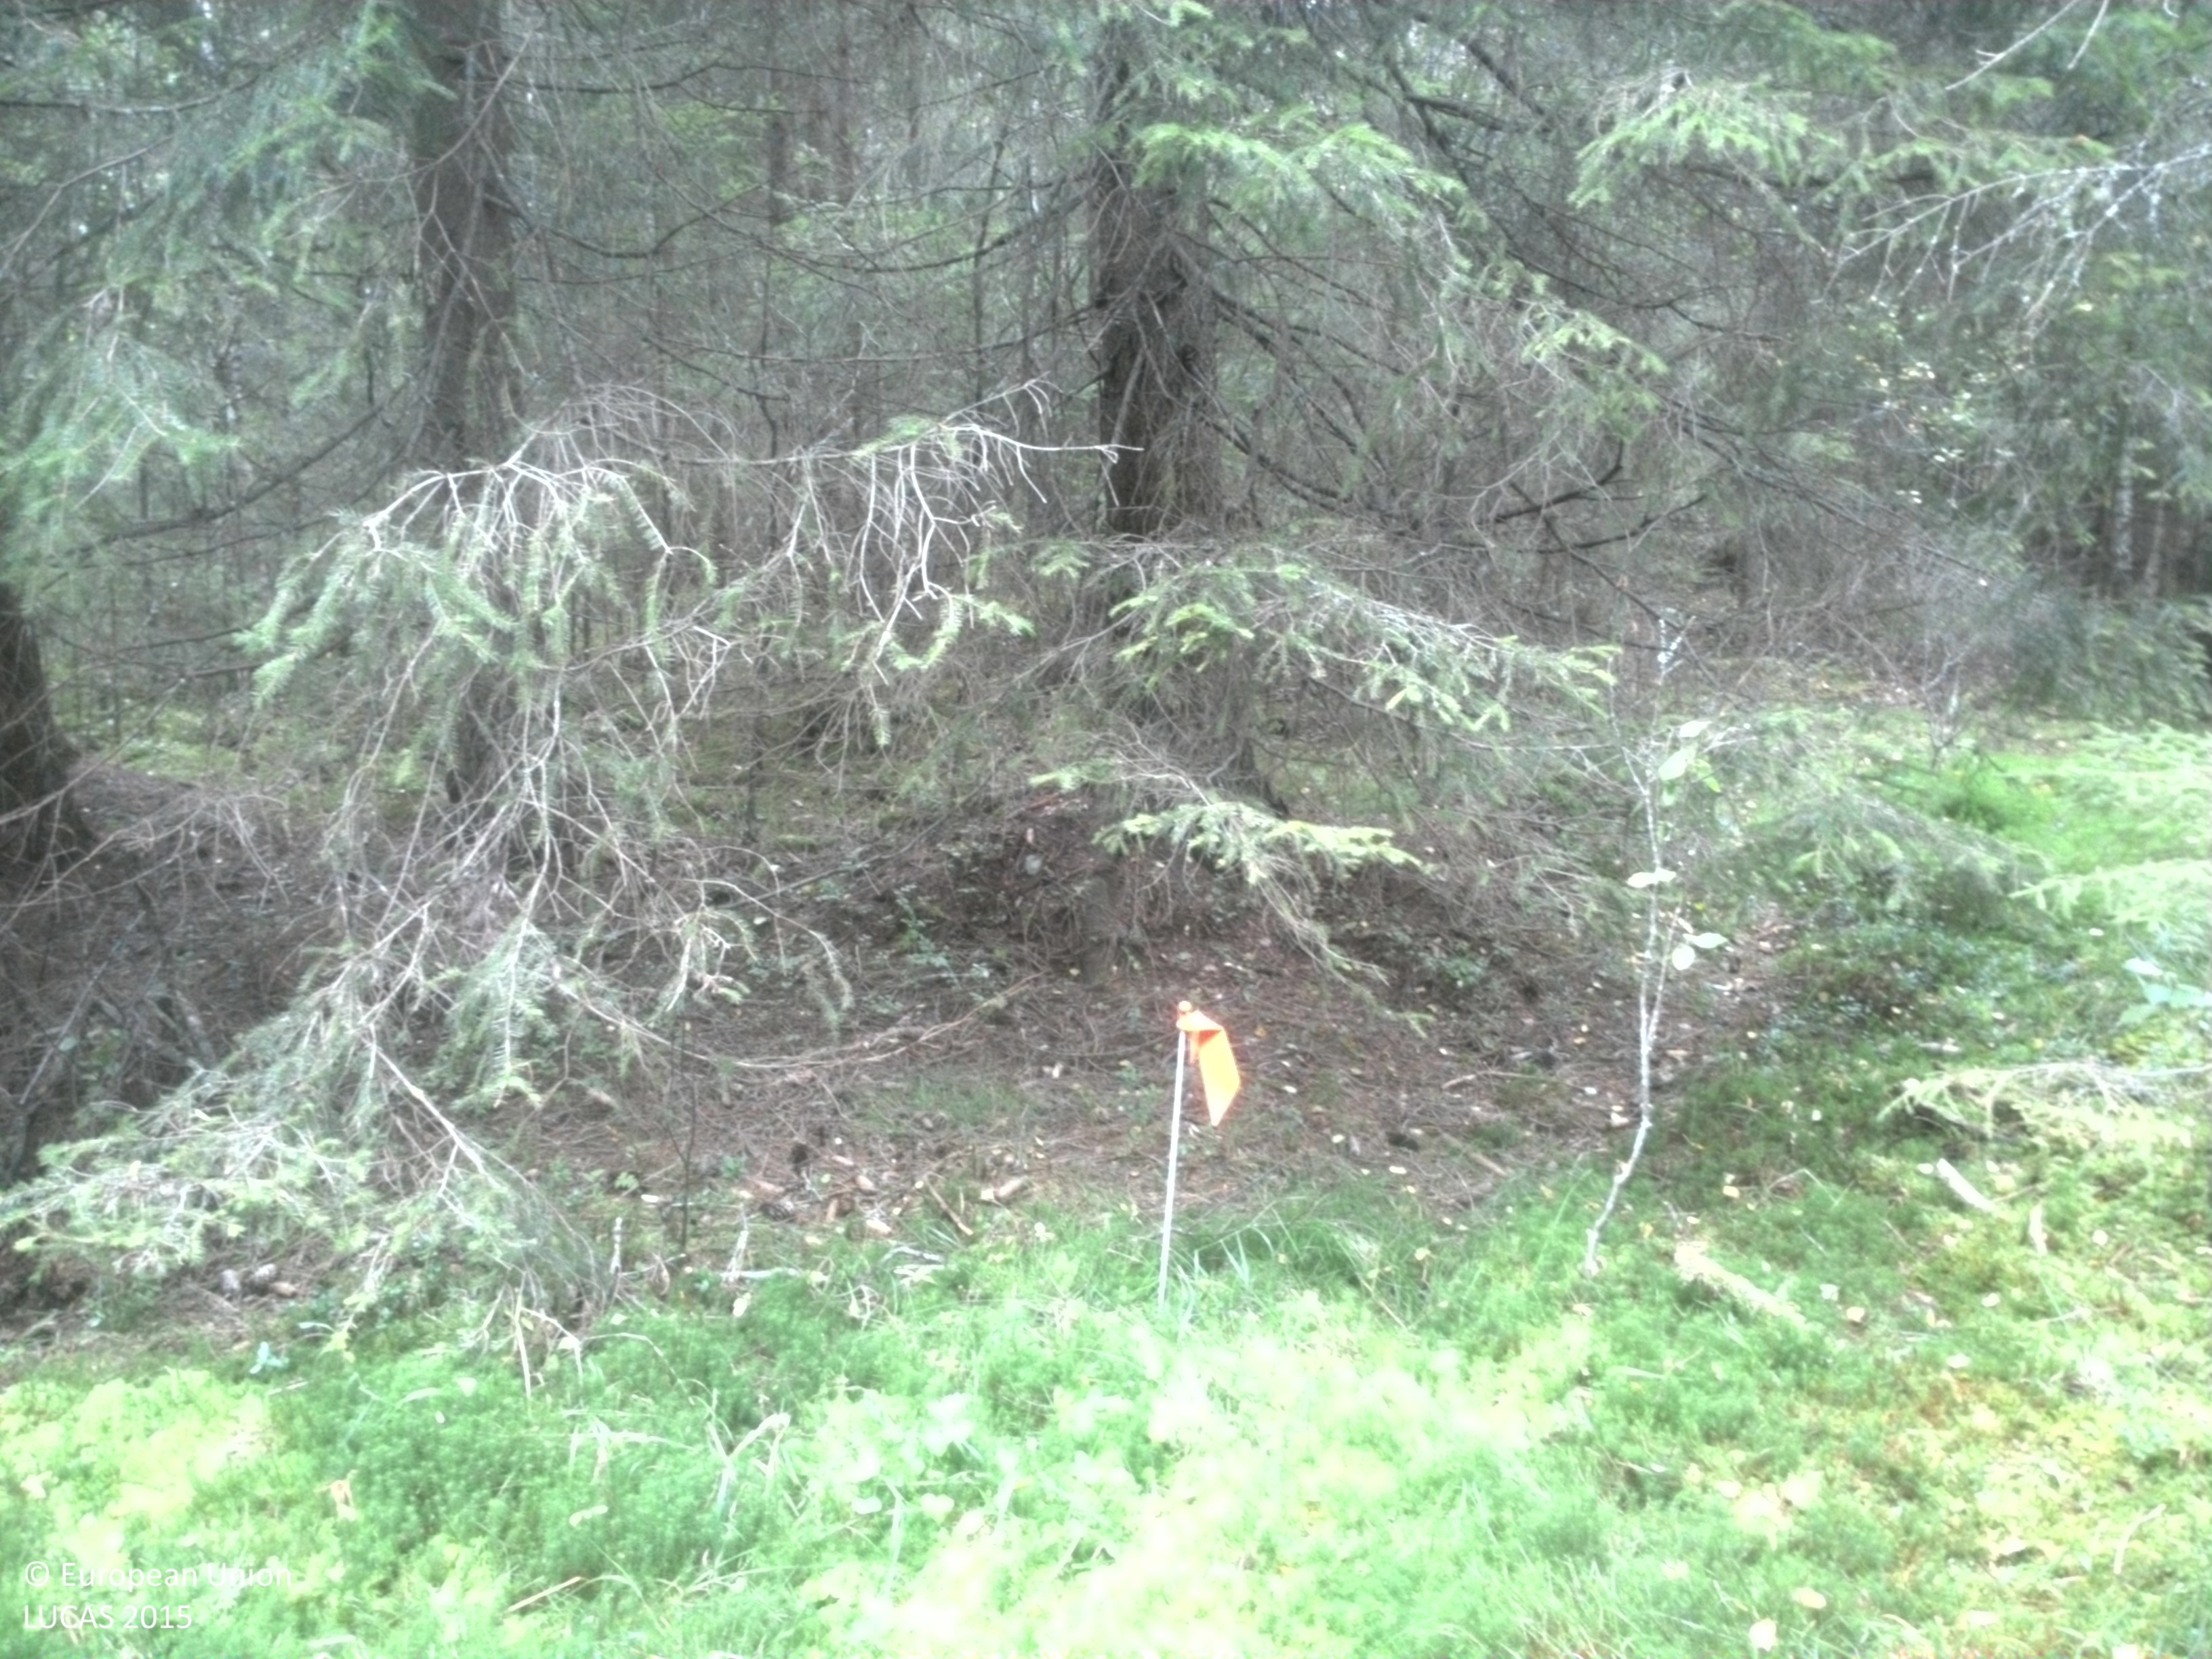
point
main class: Woodland
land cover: Spruce dominated coniferous woodland
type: boreal forest
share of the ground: 50 - 75 %
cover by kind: coniferous forest trees 60 %, lichens and mosses 20 %, broadleaved forest trees 10 %, shrubs 10 %
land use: Forestry
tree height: > 5 m
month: September
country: SE
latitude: 59.5240
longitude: 15.7008
